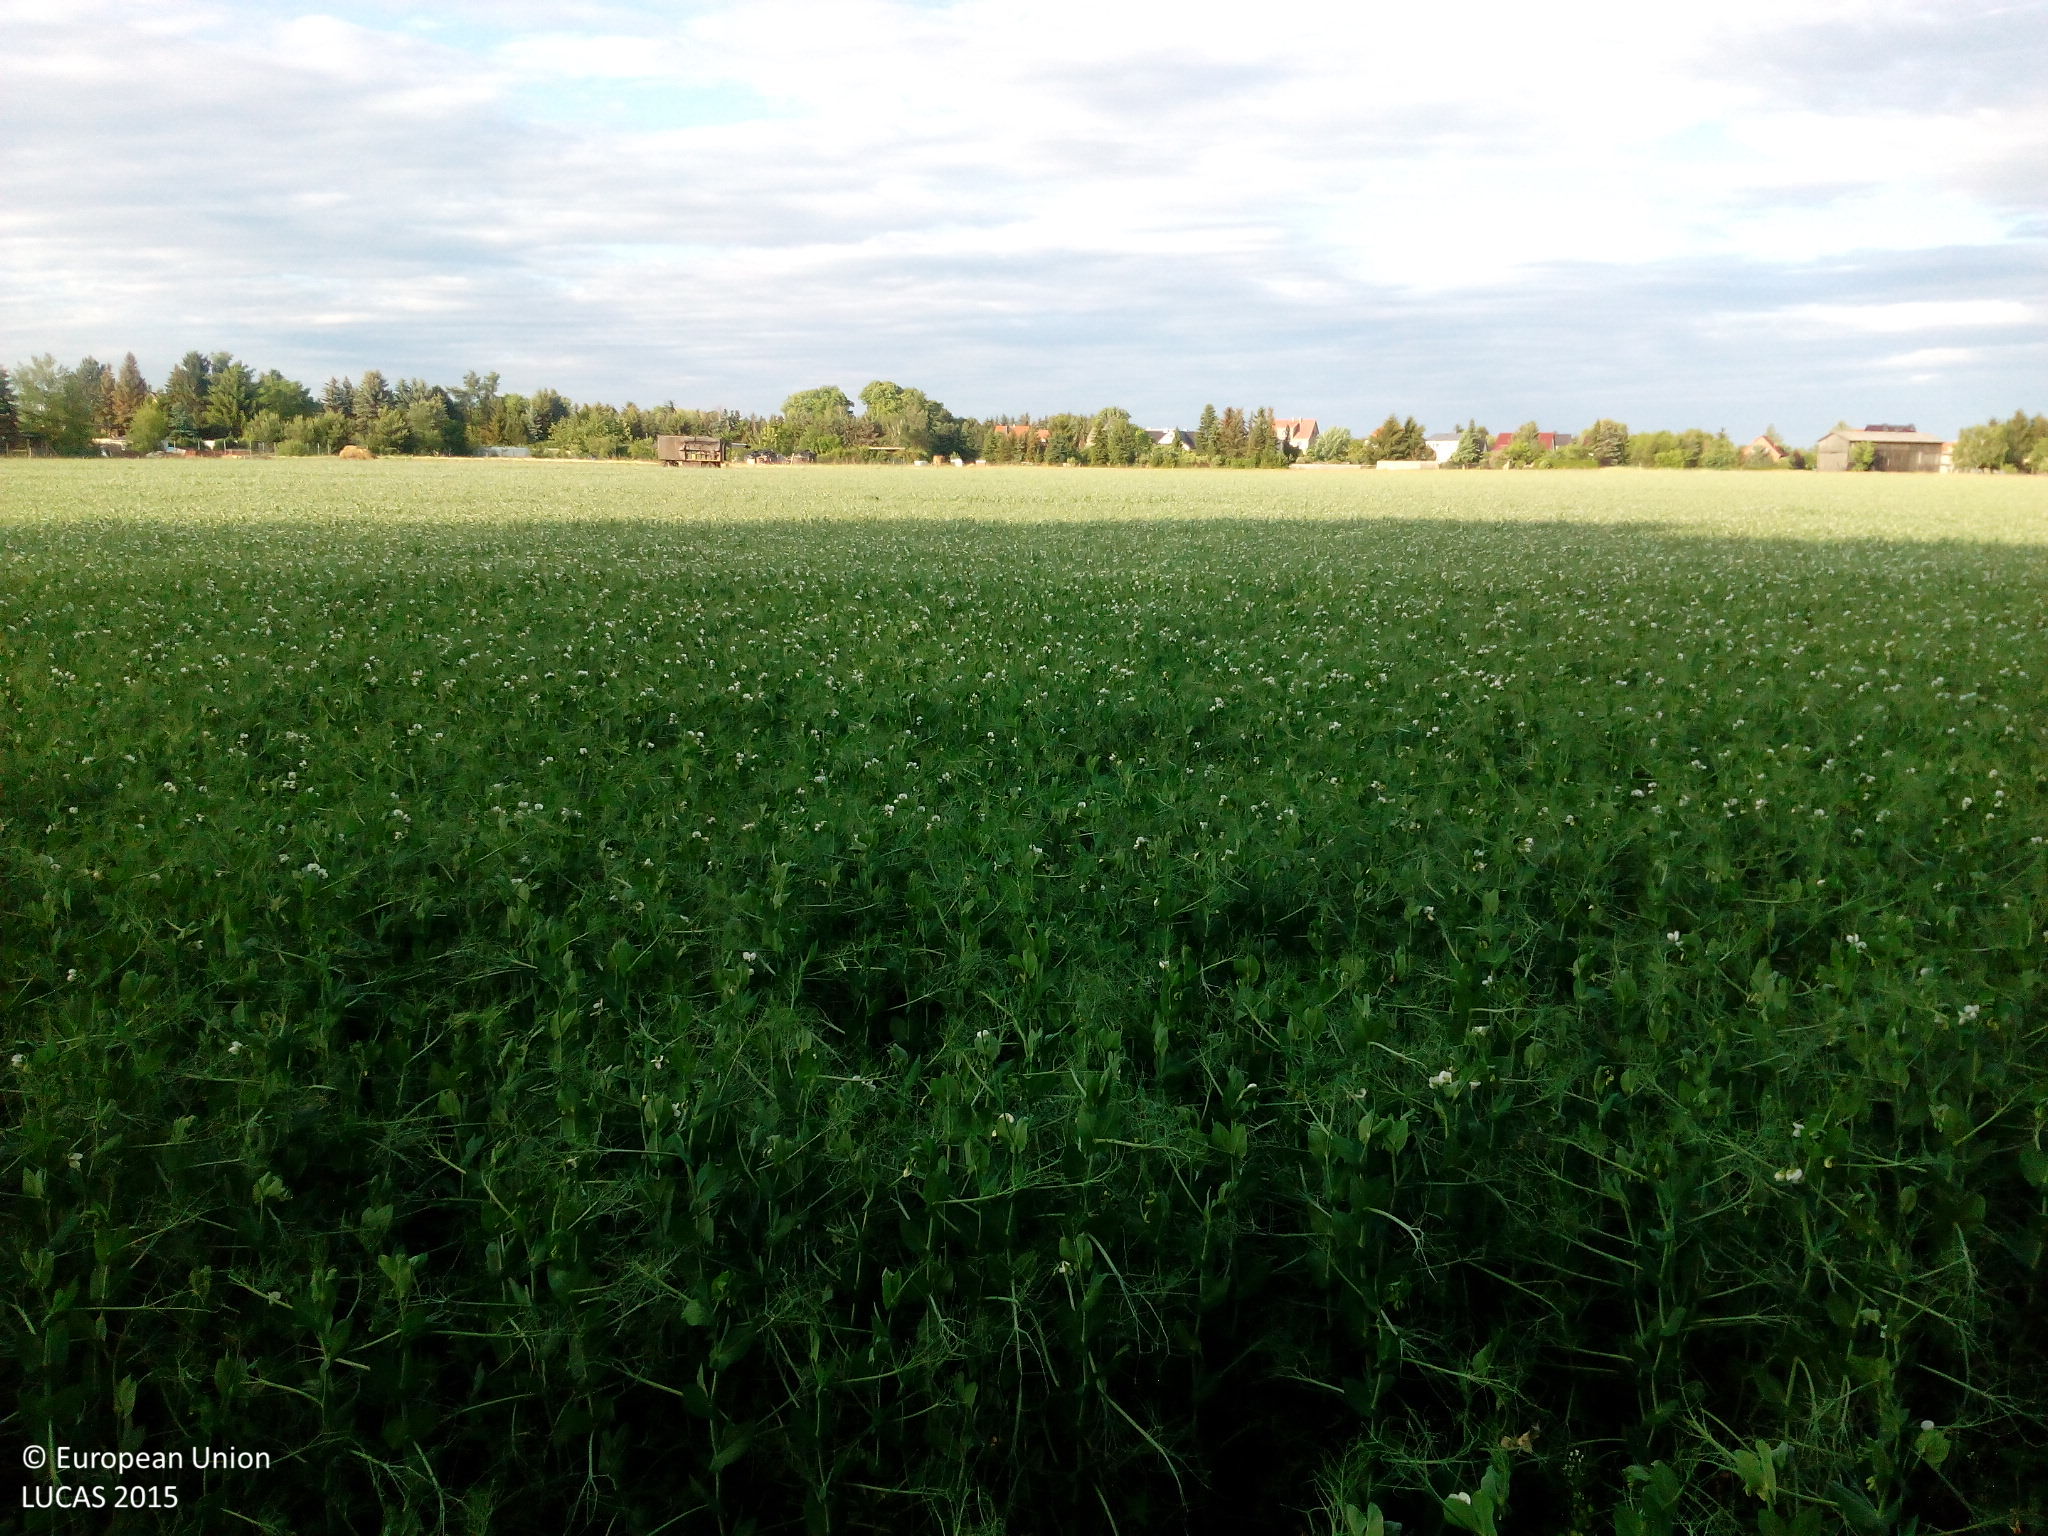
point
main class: Cropland
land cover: Dry pulses
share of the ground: > 75 %
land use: Agriculture (excluding fallow land and kitchen gardens)
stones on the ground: < 10 %
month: June
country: DE
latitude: 51.4435
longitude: 13.5254
